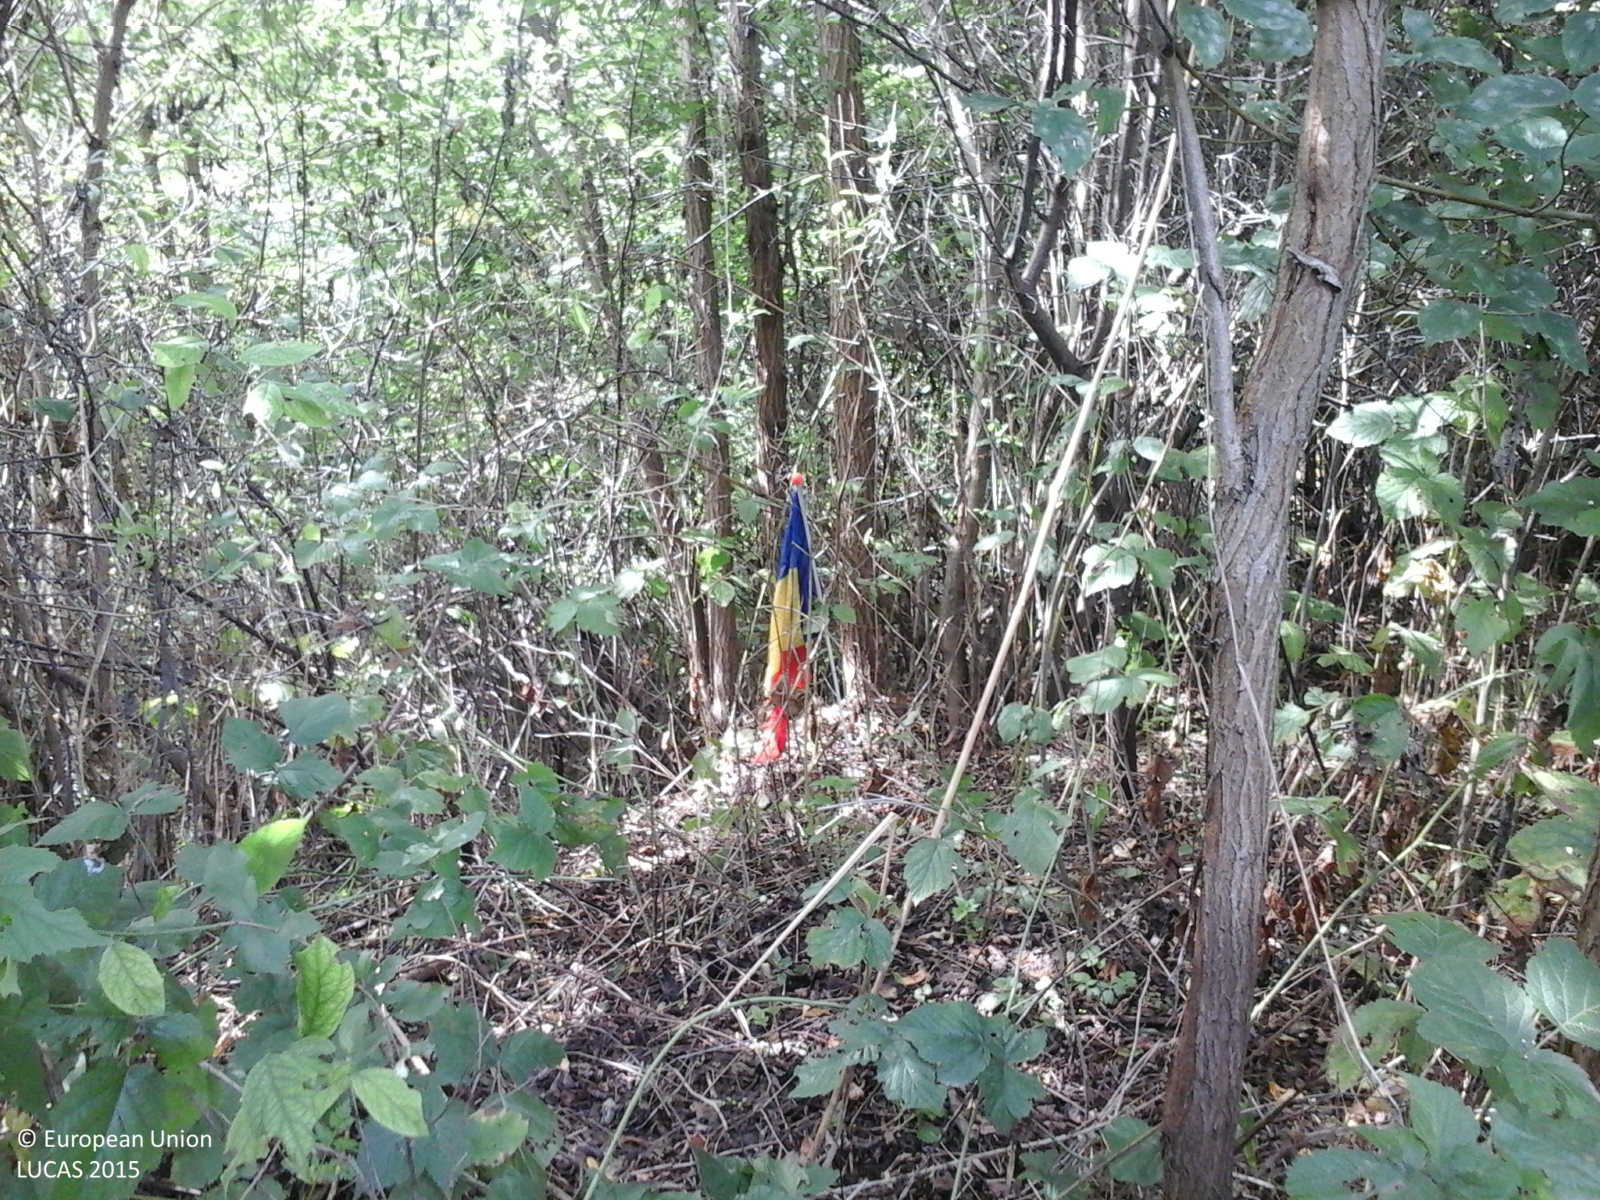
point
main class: Woodland
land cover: Broadleaved woodland
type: exotic forest
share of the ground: > 75 %
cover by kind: broadleaved forest trees 100 %
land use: Forestry
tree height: < 5 m
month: September
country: RO
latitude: 47.1479
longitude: 23.6712
